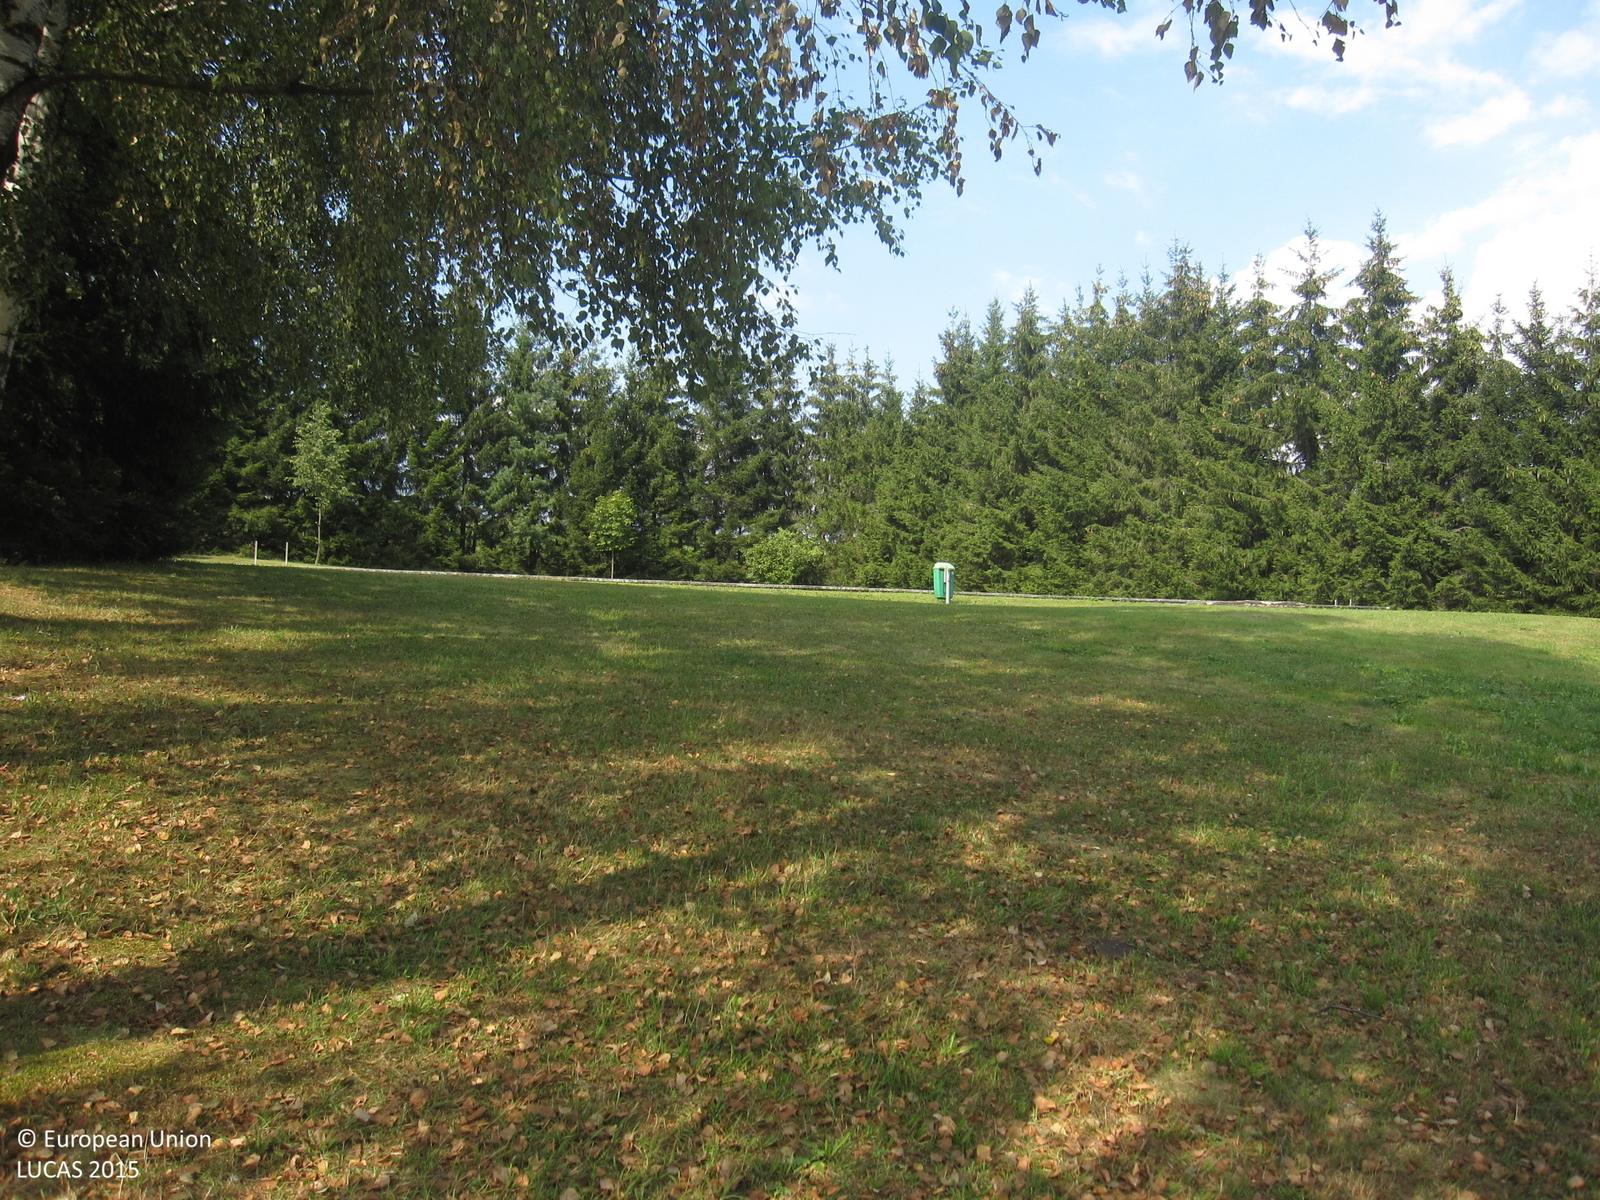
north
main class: Grassland
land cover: Grassland with sparse tree/shrub cover
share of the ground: > 75 %
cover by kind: herbaceous plants 90 %, broadleaved forest trees 5 %, consolidated bare surface 5 %
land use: Amenities, museums, leisure
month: August
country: DE
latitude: 50.4609
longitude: 11.5914
